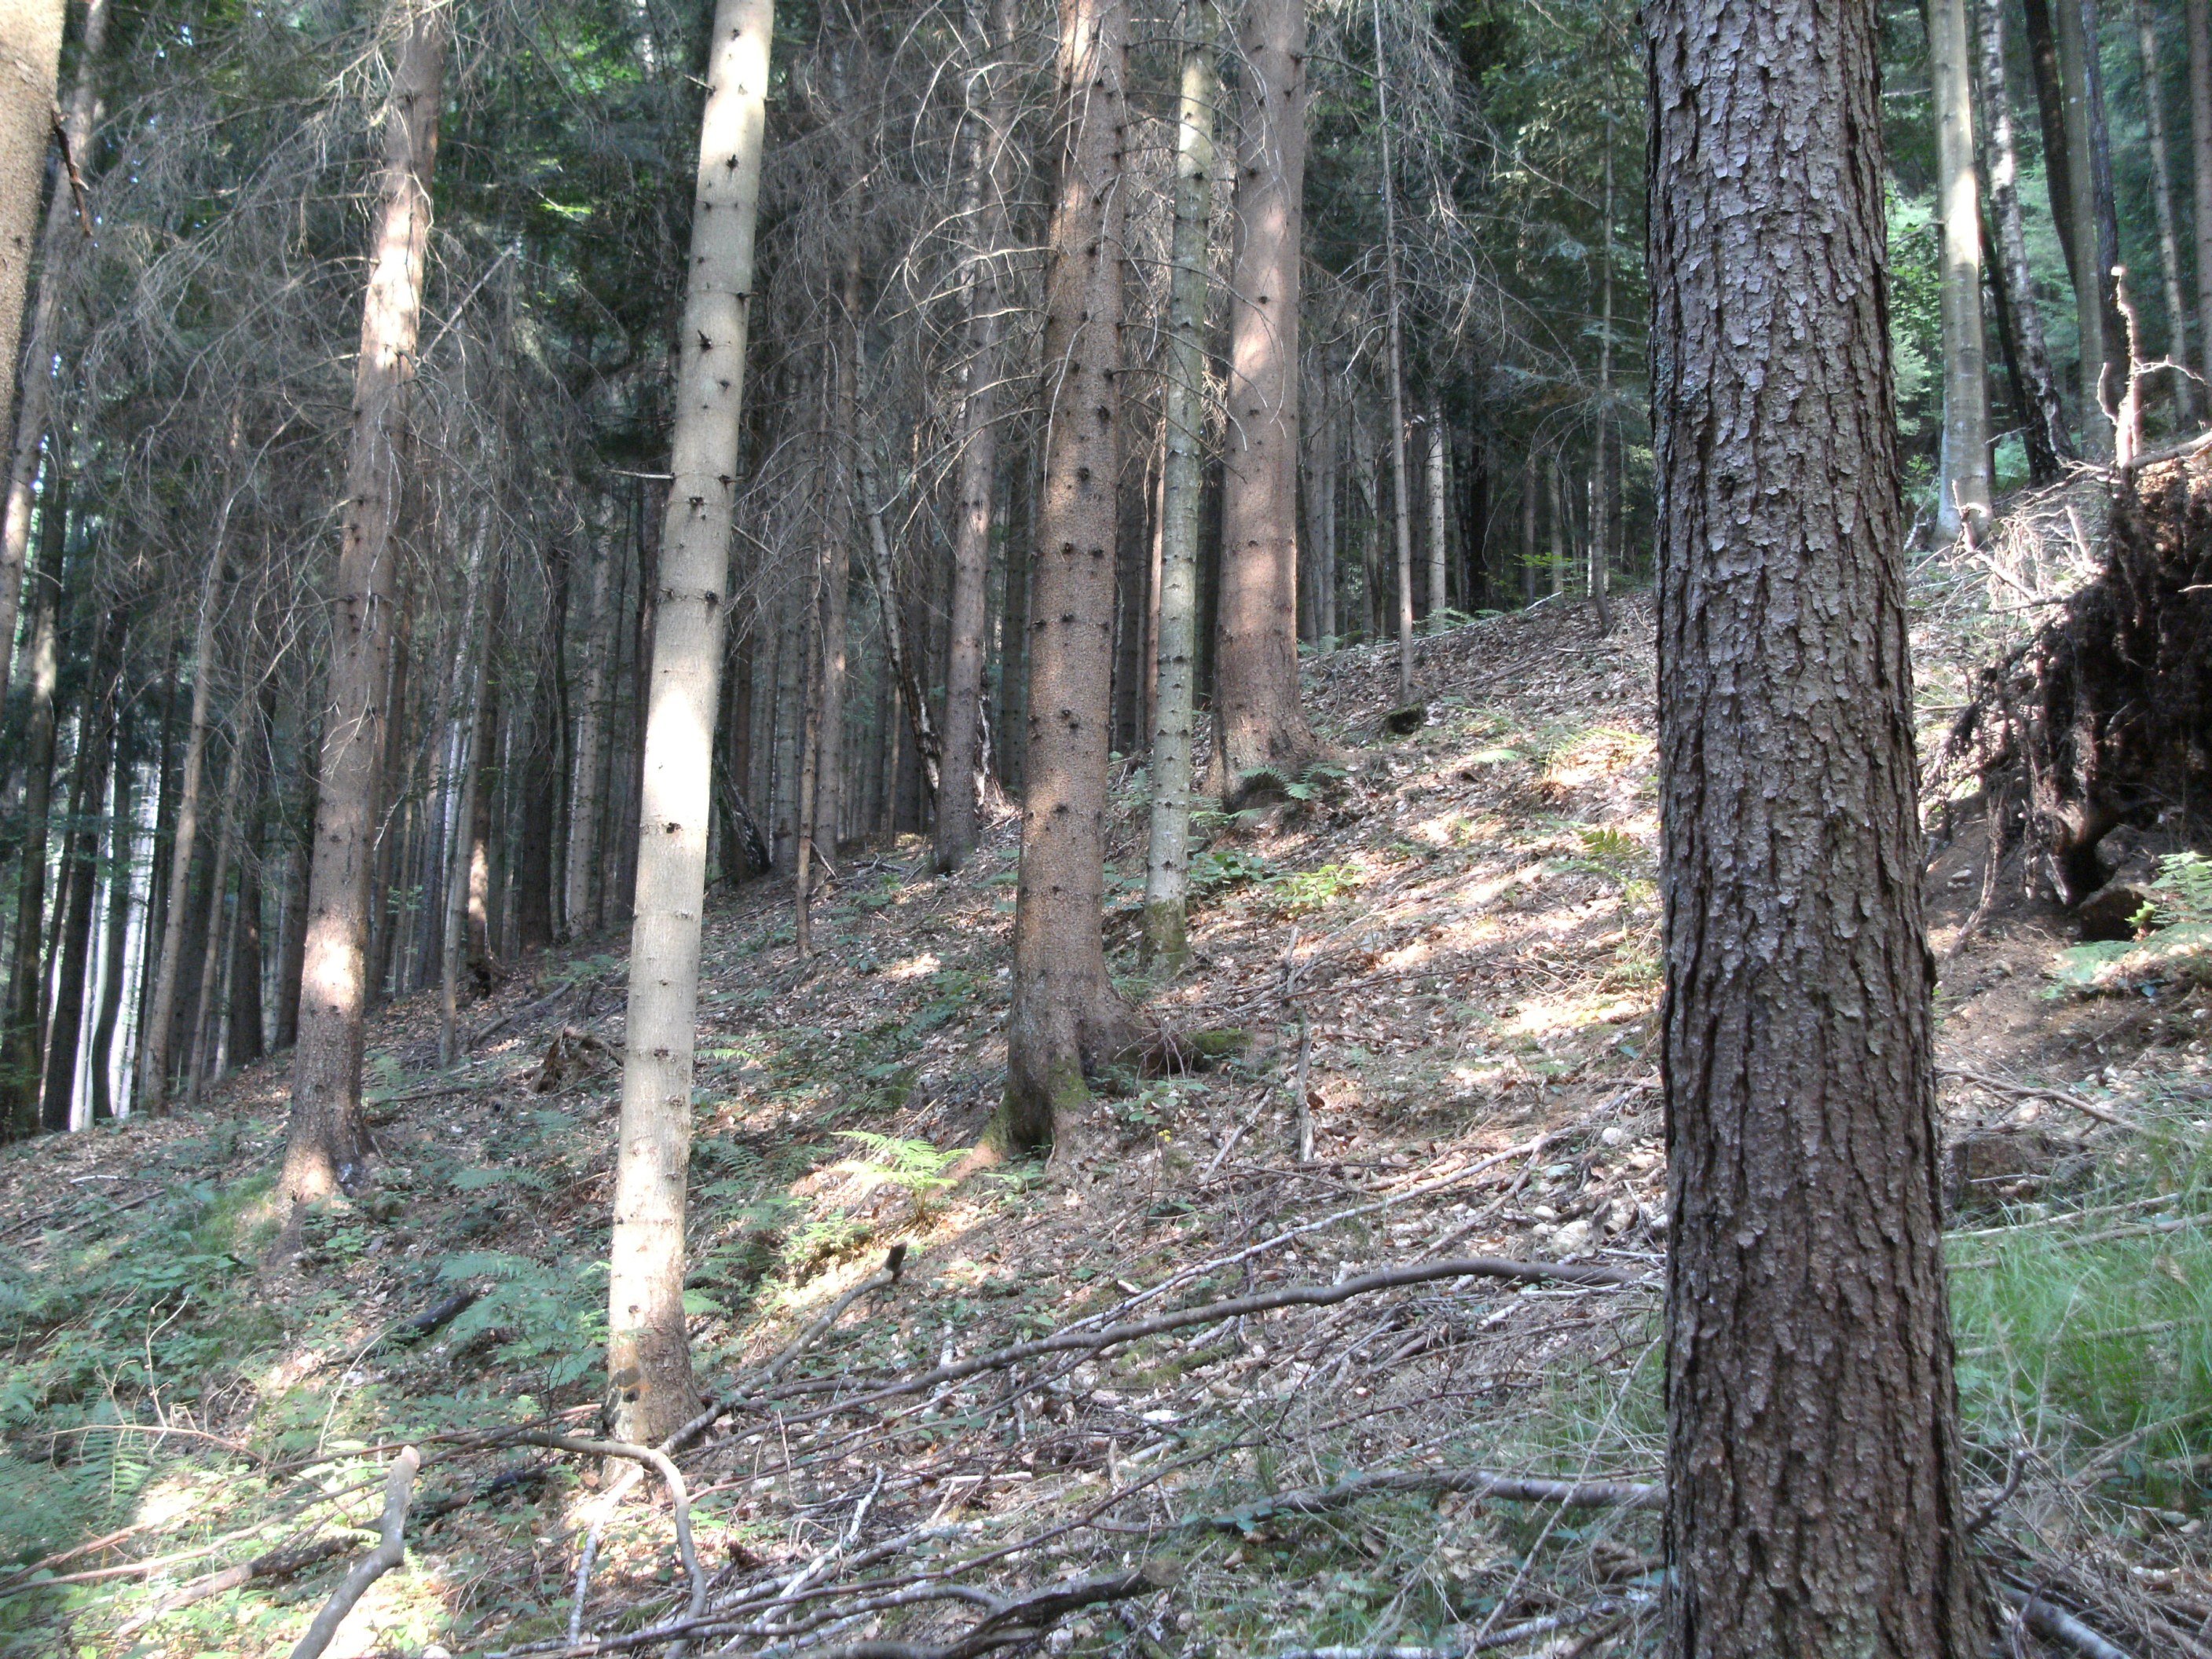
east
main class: Woodland
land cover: Spruce dominated coniferous woodland
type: hemiboreal forest and nemoral coniferous forest and mixed broadleaved-coniferous forest
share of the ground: > 75 %
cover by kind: coniferous forest trees 70 %, broadleaved forest trees 10 %, shrubs 5 %, herbaceous plants 5 %, lichens and mosses 5 %, unconsolidated bare surface 5 %
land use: Forestry
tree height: > 5 m
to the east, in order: Spruce dominated coniferous woodland; Spruce dominated mixed woodland; Spruce dominated coniferous woodland; Paved roads, cycling and walking lanes; Spruce dominated mixed woodland; Fences; Spruce dominated mixed woodland; Grassland without tree/shrub cover
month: July
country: AT
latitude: 46.5475
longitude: 14.4446
